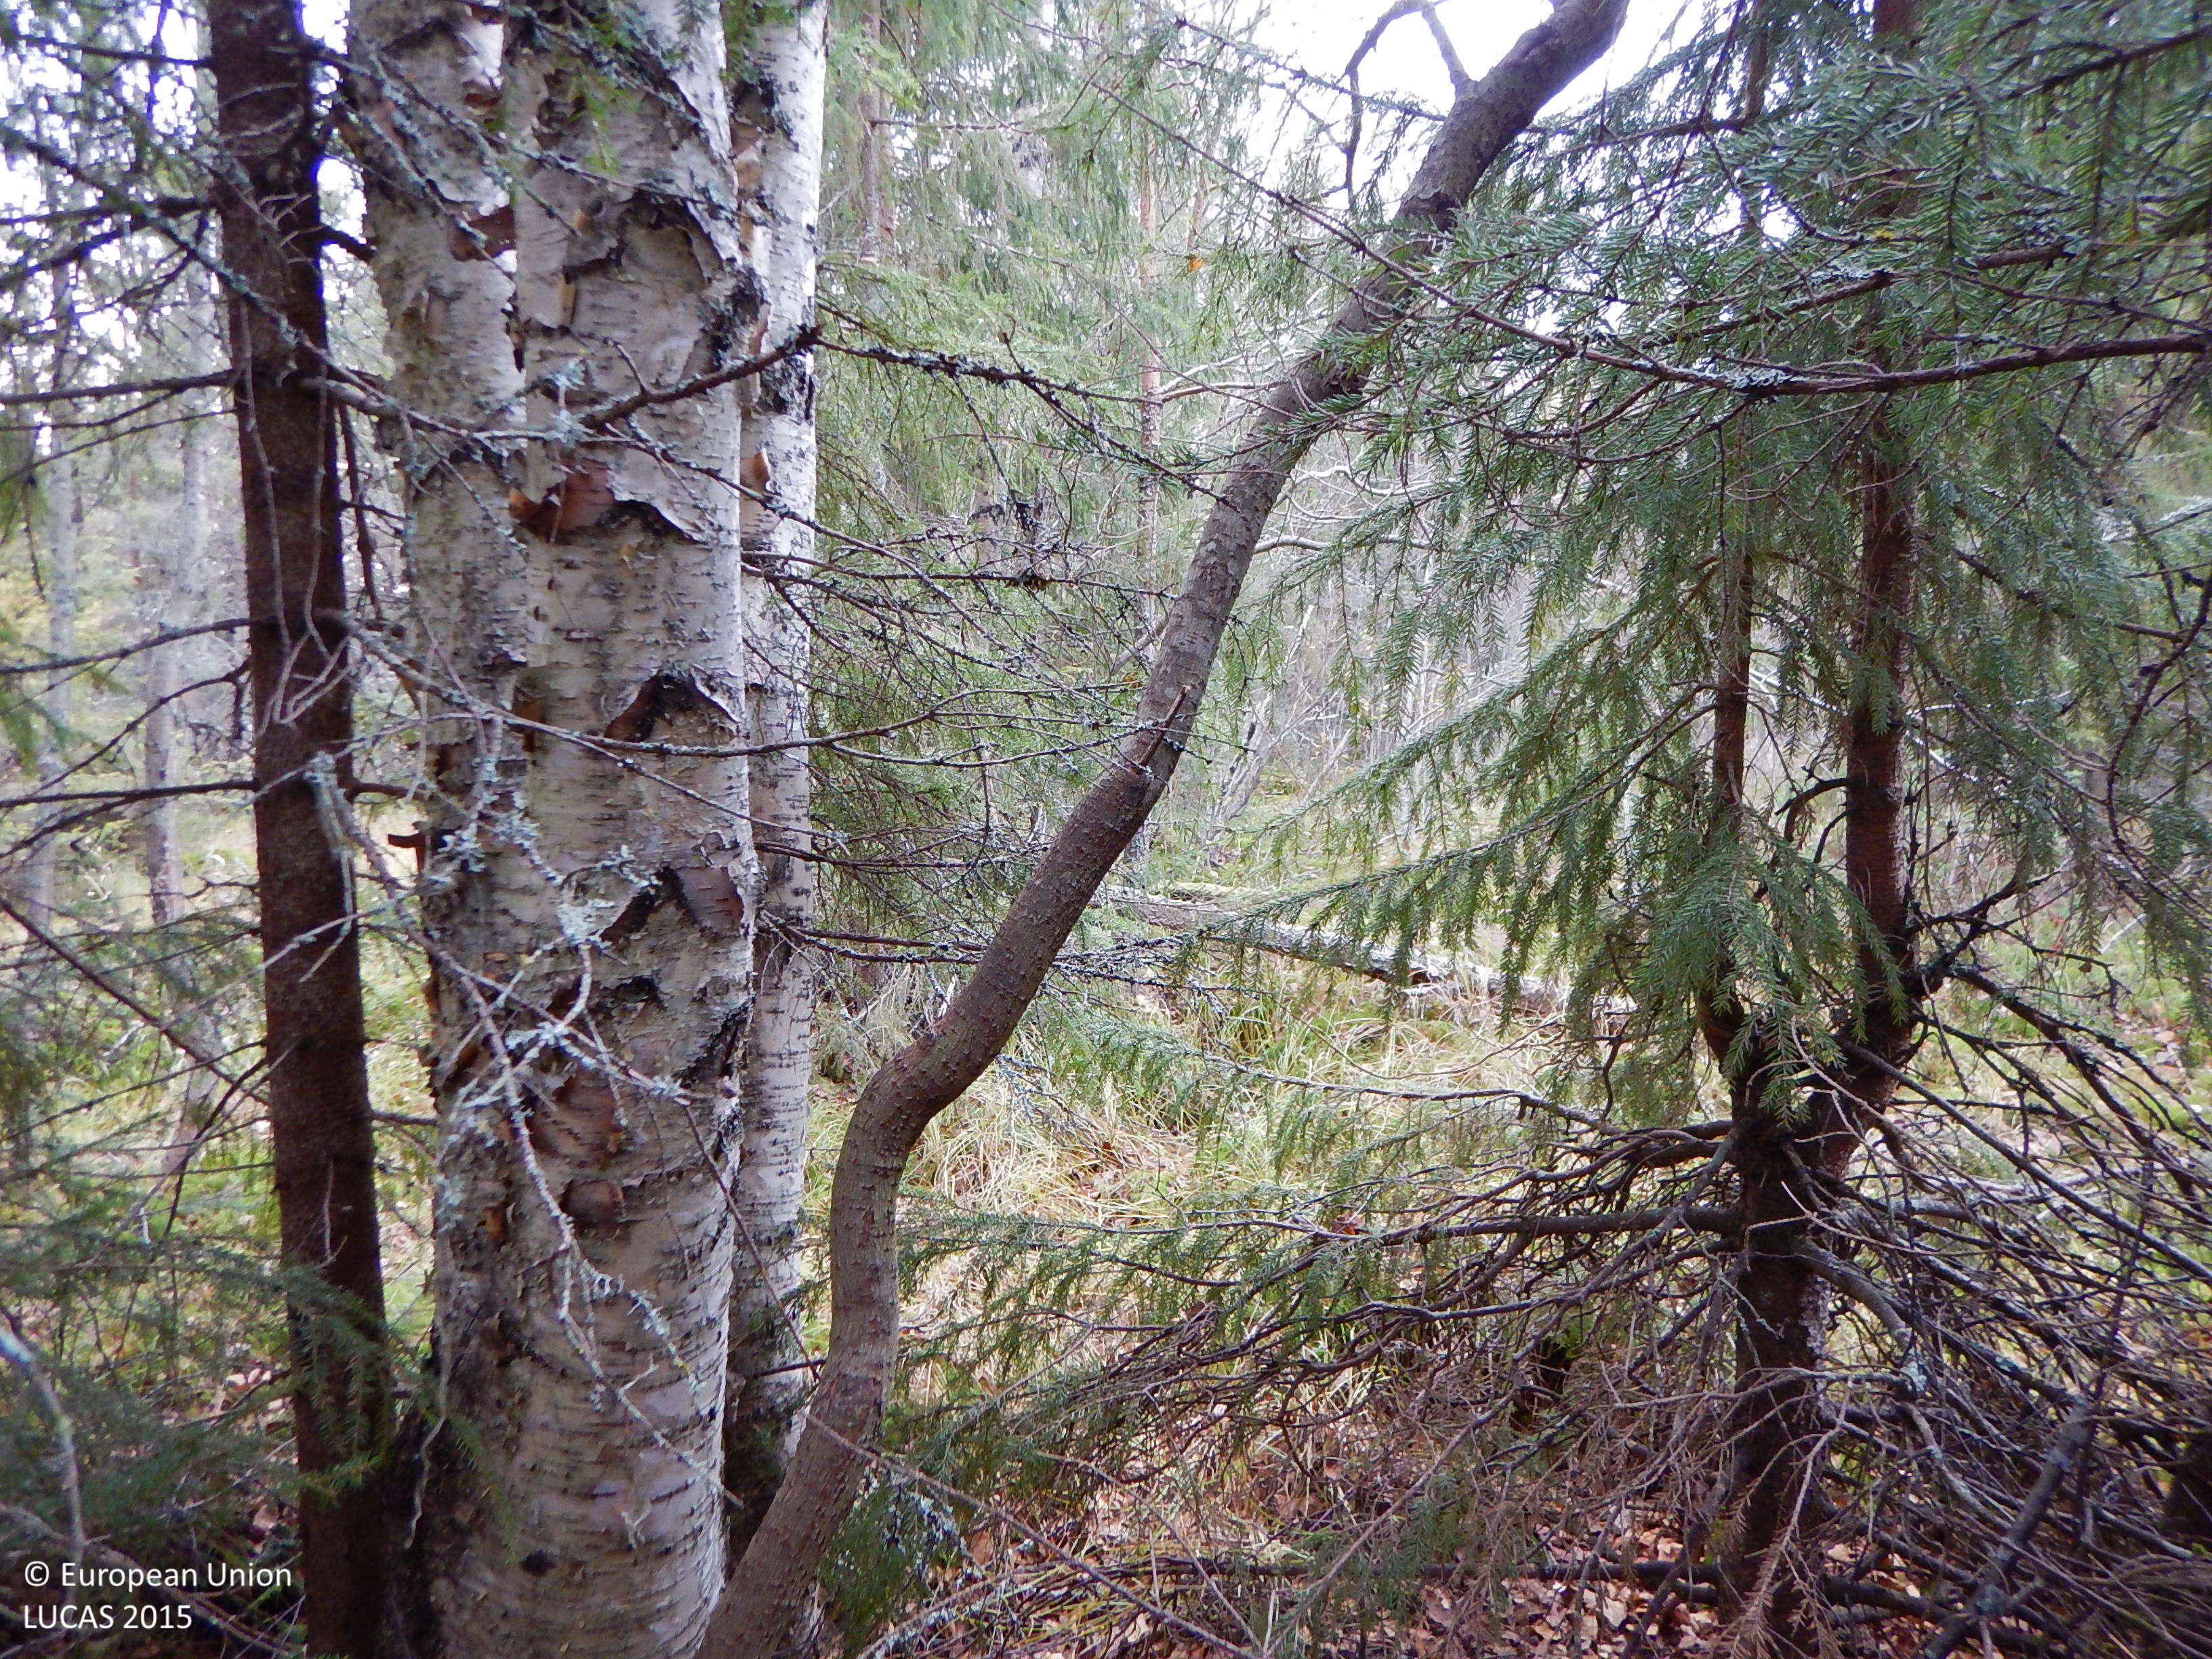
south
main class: Woodland
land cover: Spruce dominated mixed woodland
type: boreal forest
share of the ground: 50 - 75 %
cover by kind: coniferous forest trees 45 %, broadleaved forest trees 20 %, shrubs 15 %, herbaceous plants 15 %, lichens and mosses 5 %
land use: Forestry
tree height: > 5 m
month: October
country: SE
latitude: 65.1487
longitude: 21.5154
